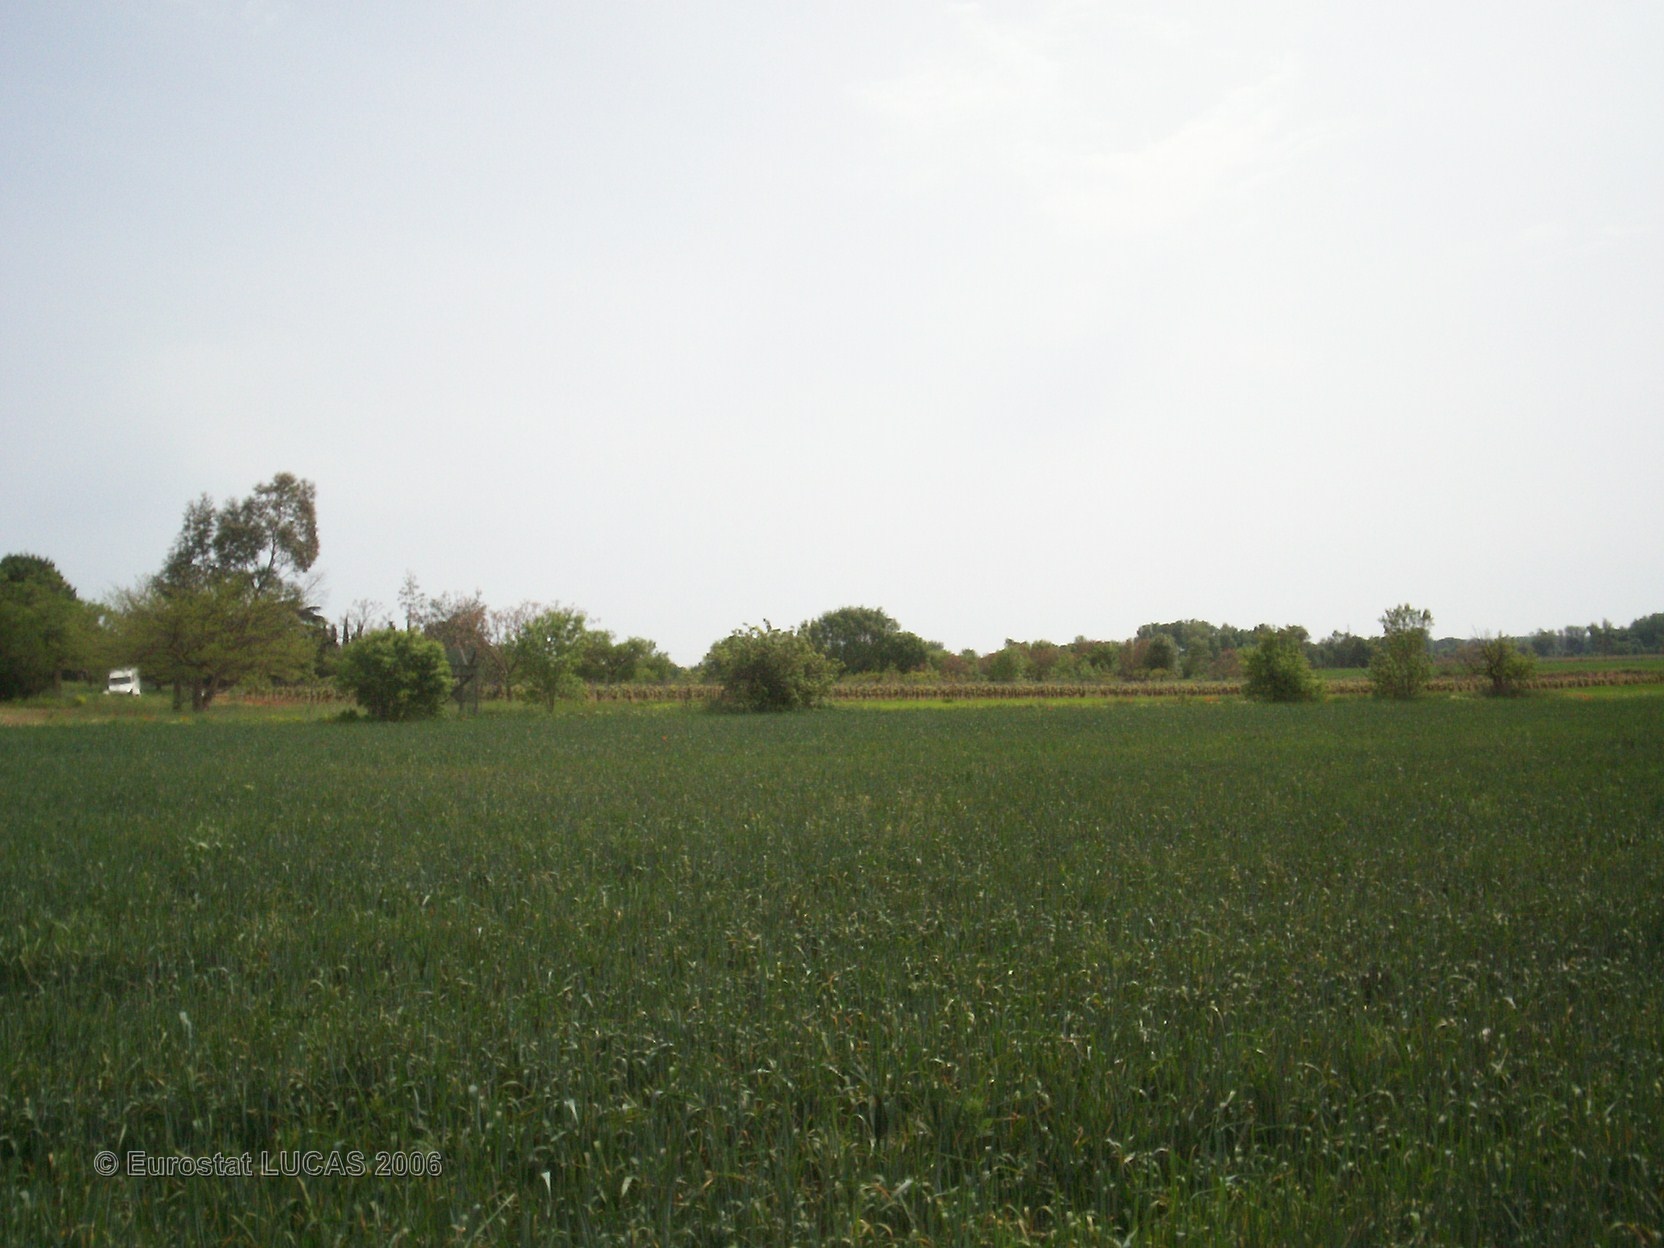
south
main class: Cropland
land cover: Common wheat
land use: Agriculture (excluding fallow land and kitchen gardens)
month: April
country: FR
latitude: 43.4018
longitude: 3.4530
